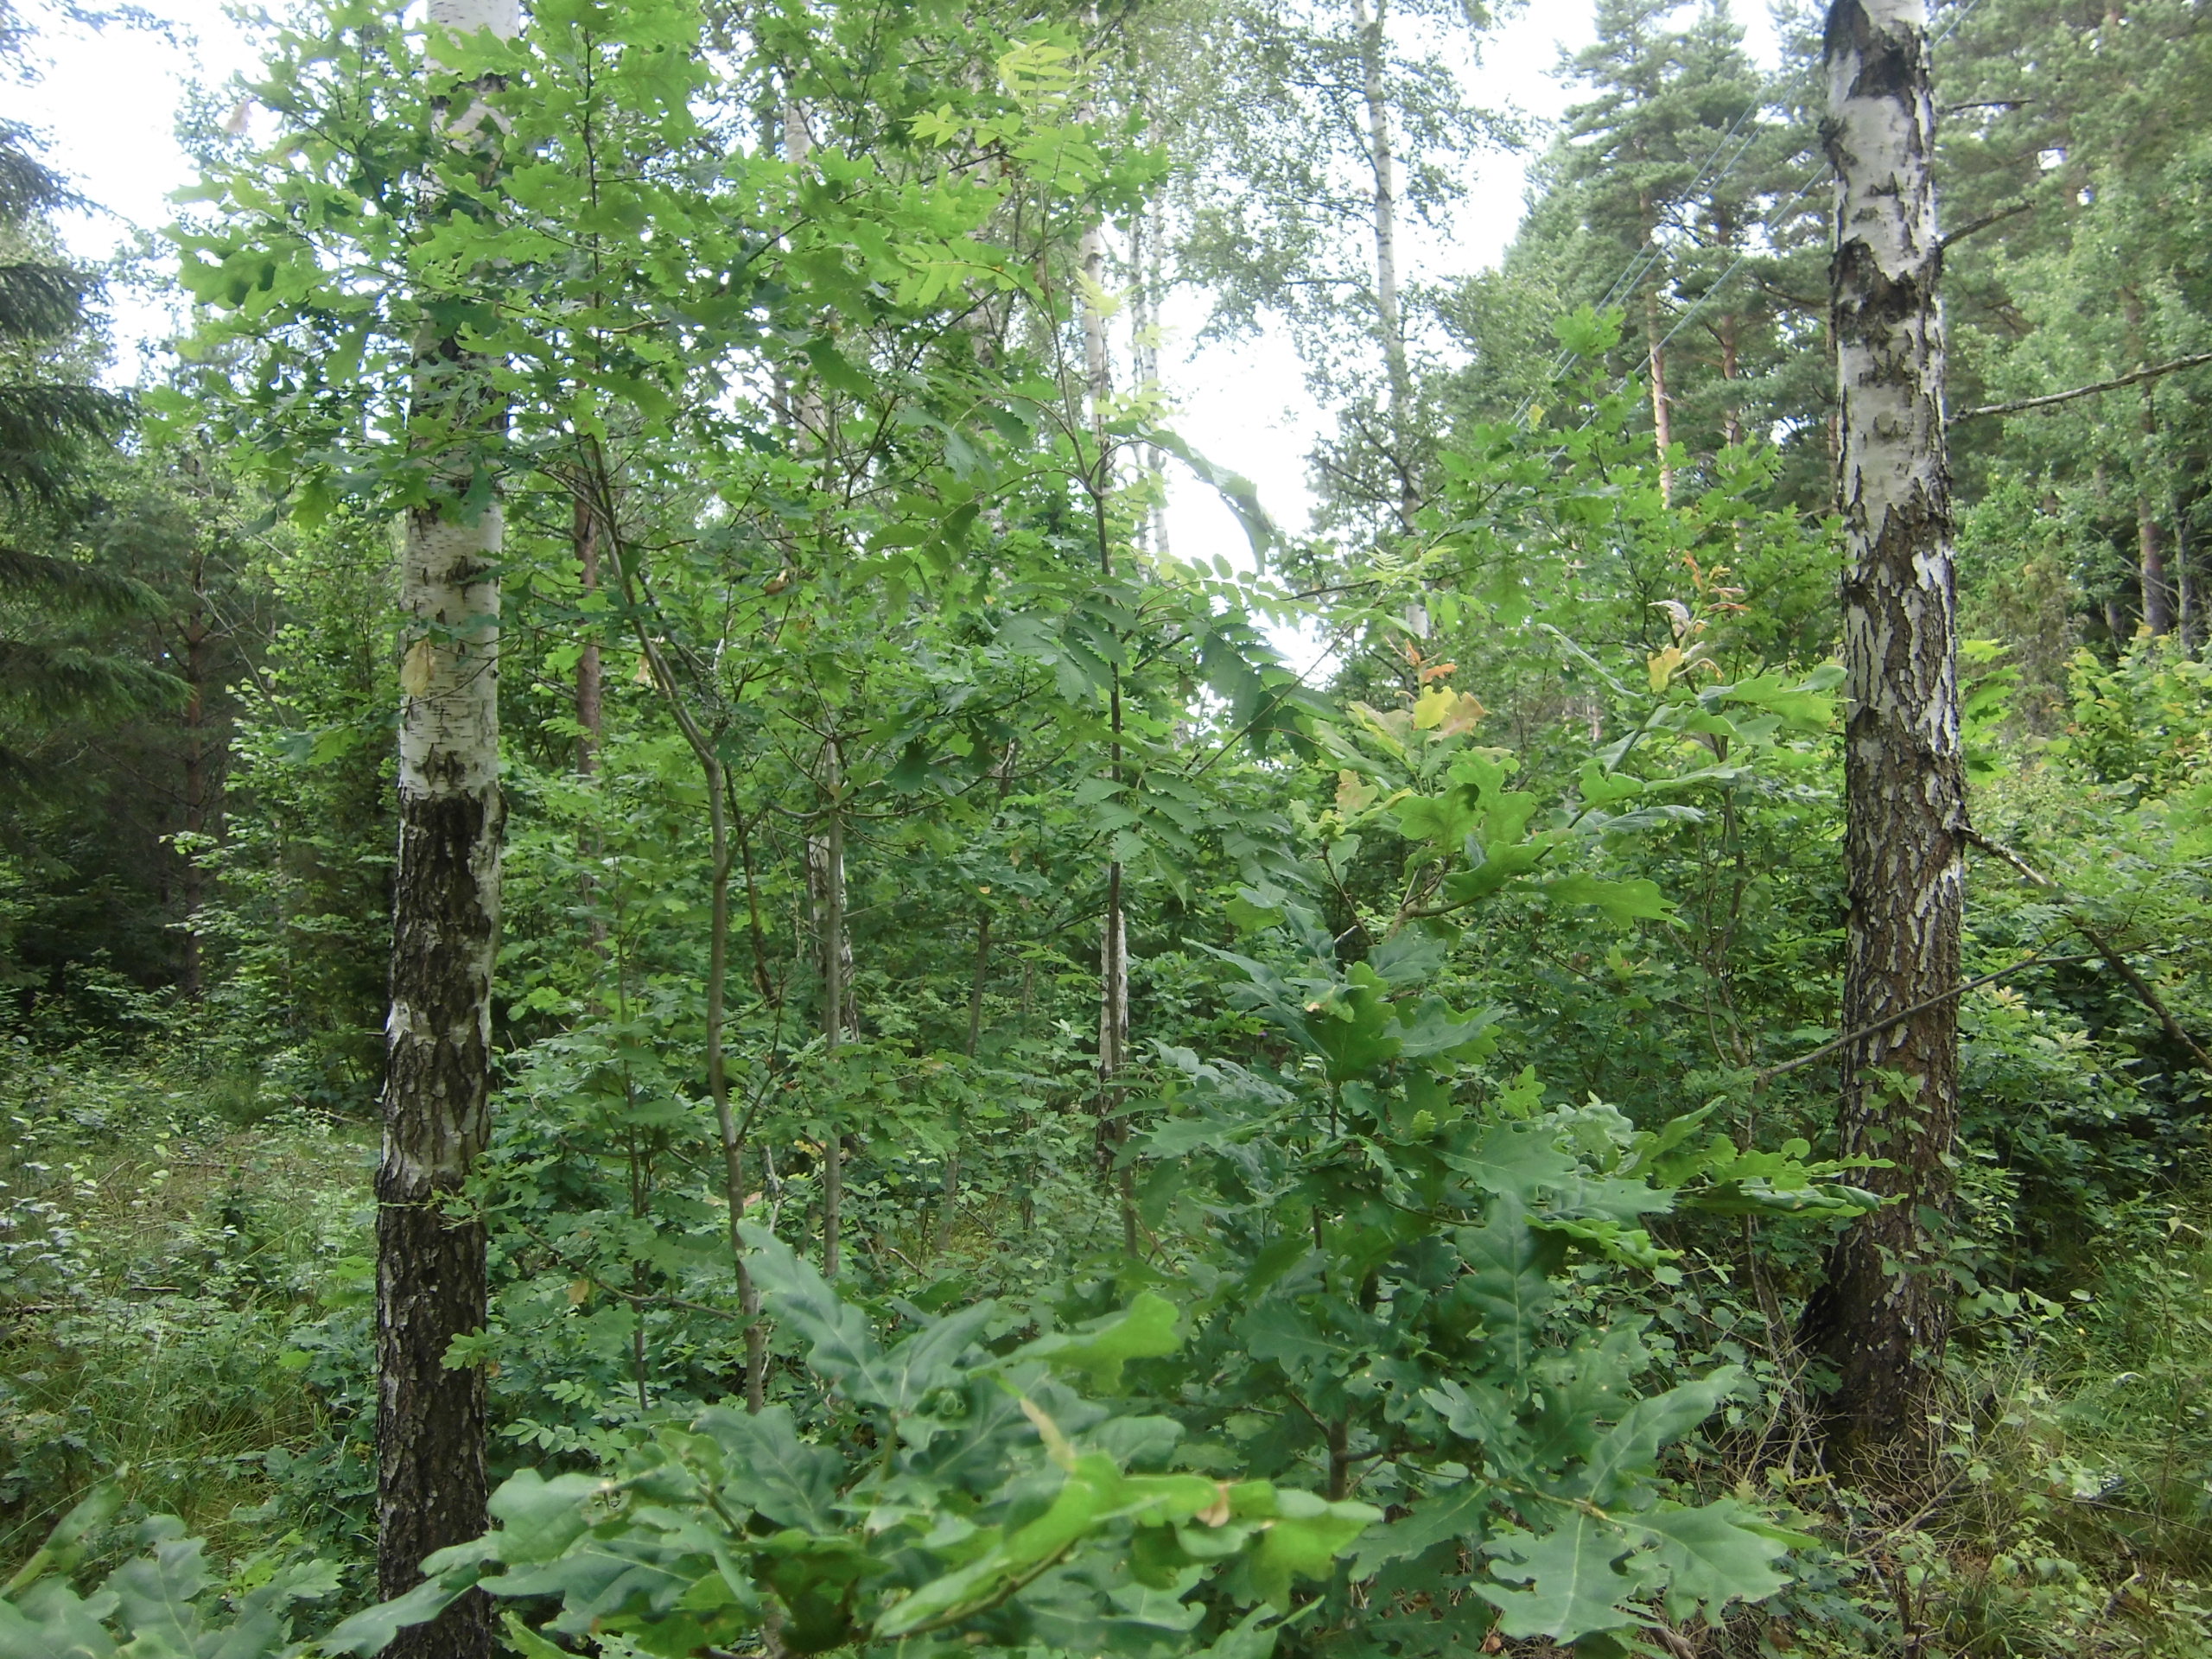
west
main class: Woodland
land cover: Broadleaved woodland
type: hemiboreal forest and nemoral coniferous forest and mixed broadleaved-coniferous forest
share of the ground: 50 - 75 %
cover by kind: broadleaved forest trees 55 %, herbaceous plants 25 %, shrubs 10 %, coniferous forest trees 5 %, lichens and mosses 5 %
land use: Forestry
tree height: > 5 m
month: July
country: SE
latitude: 57.2202
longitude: 15.5785
